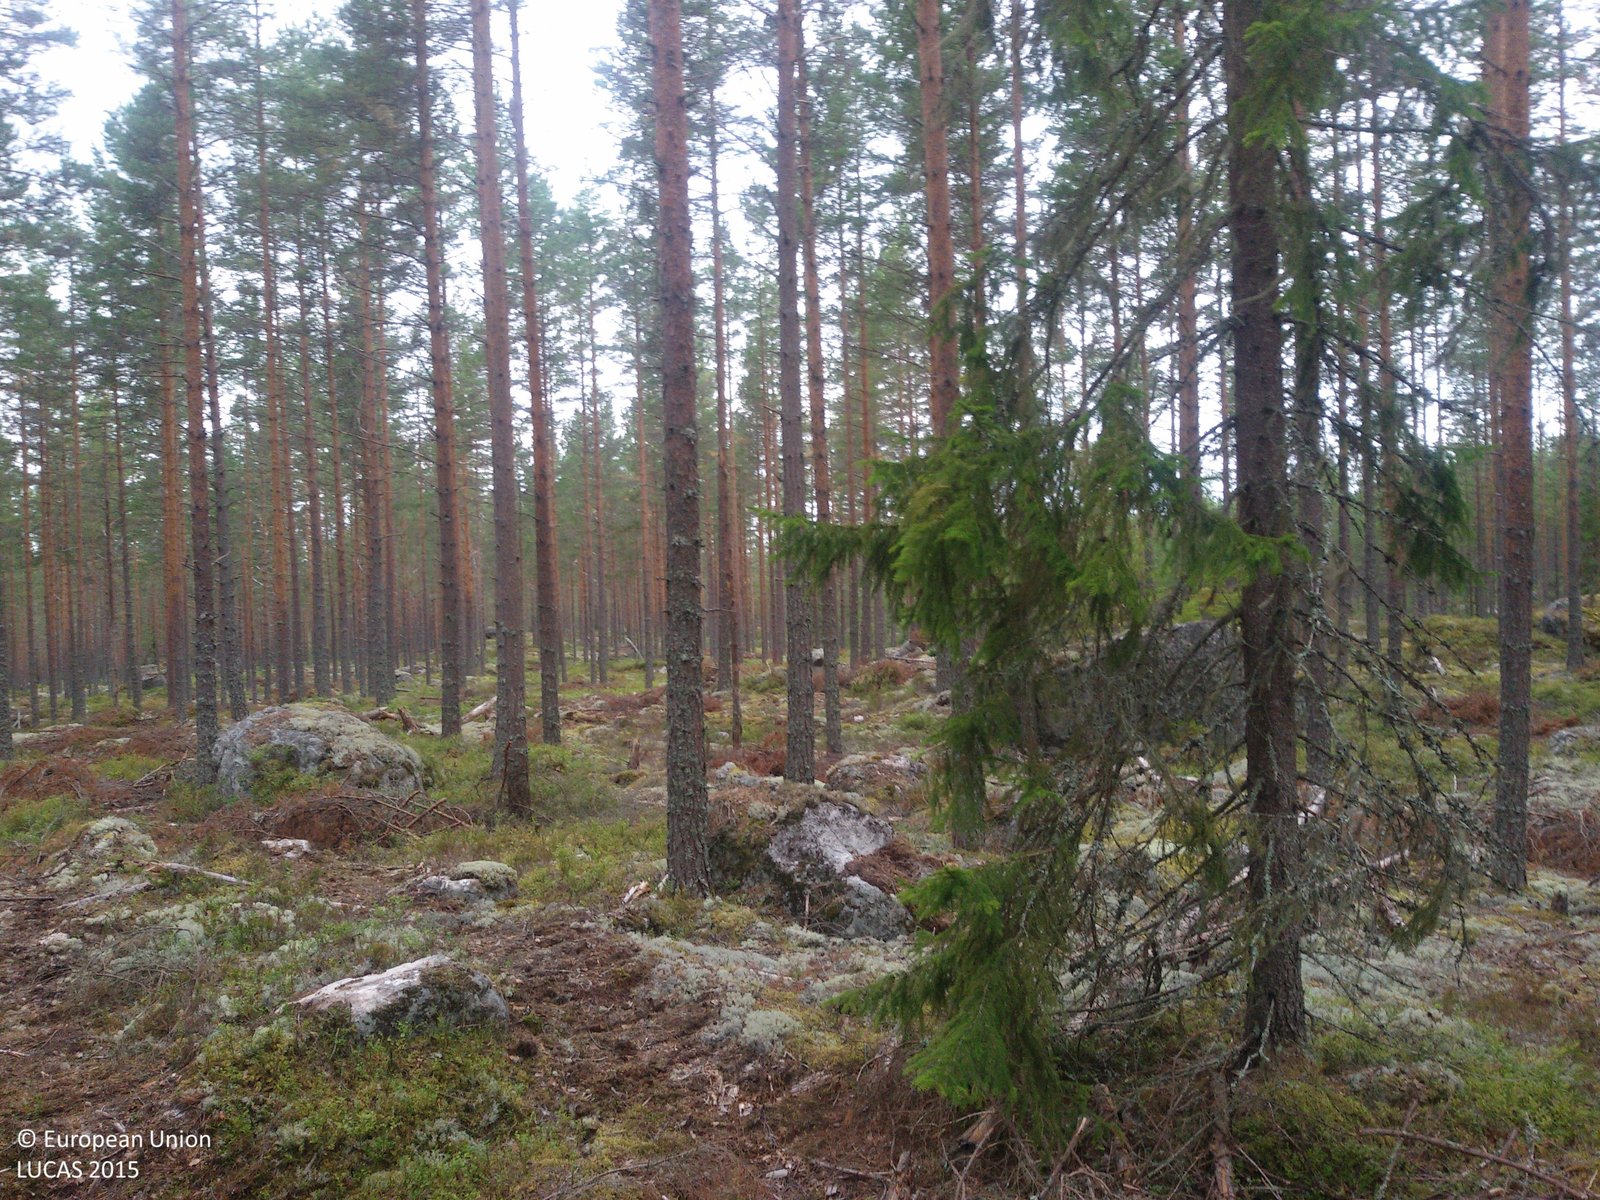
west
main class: Woodland
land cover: Pine dominated coniferous woodland
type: boreal forest
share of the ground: 50 - 75 %
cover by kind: coniferous forest trees 50 %, herbaceous plants 25 %, lichens and mosses 15 %, shrubs 10 %
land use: Forestry
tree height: > 5 m
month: September
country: SE
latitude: 60.7713
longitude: 15.6597
